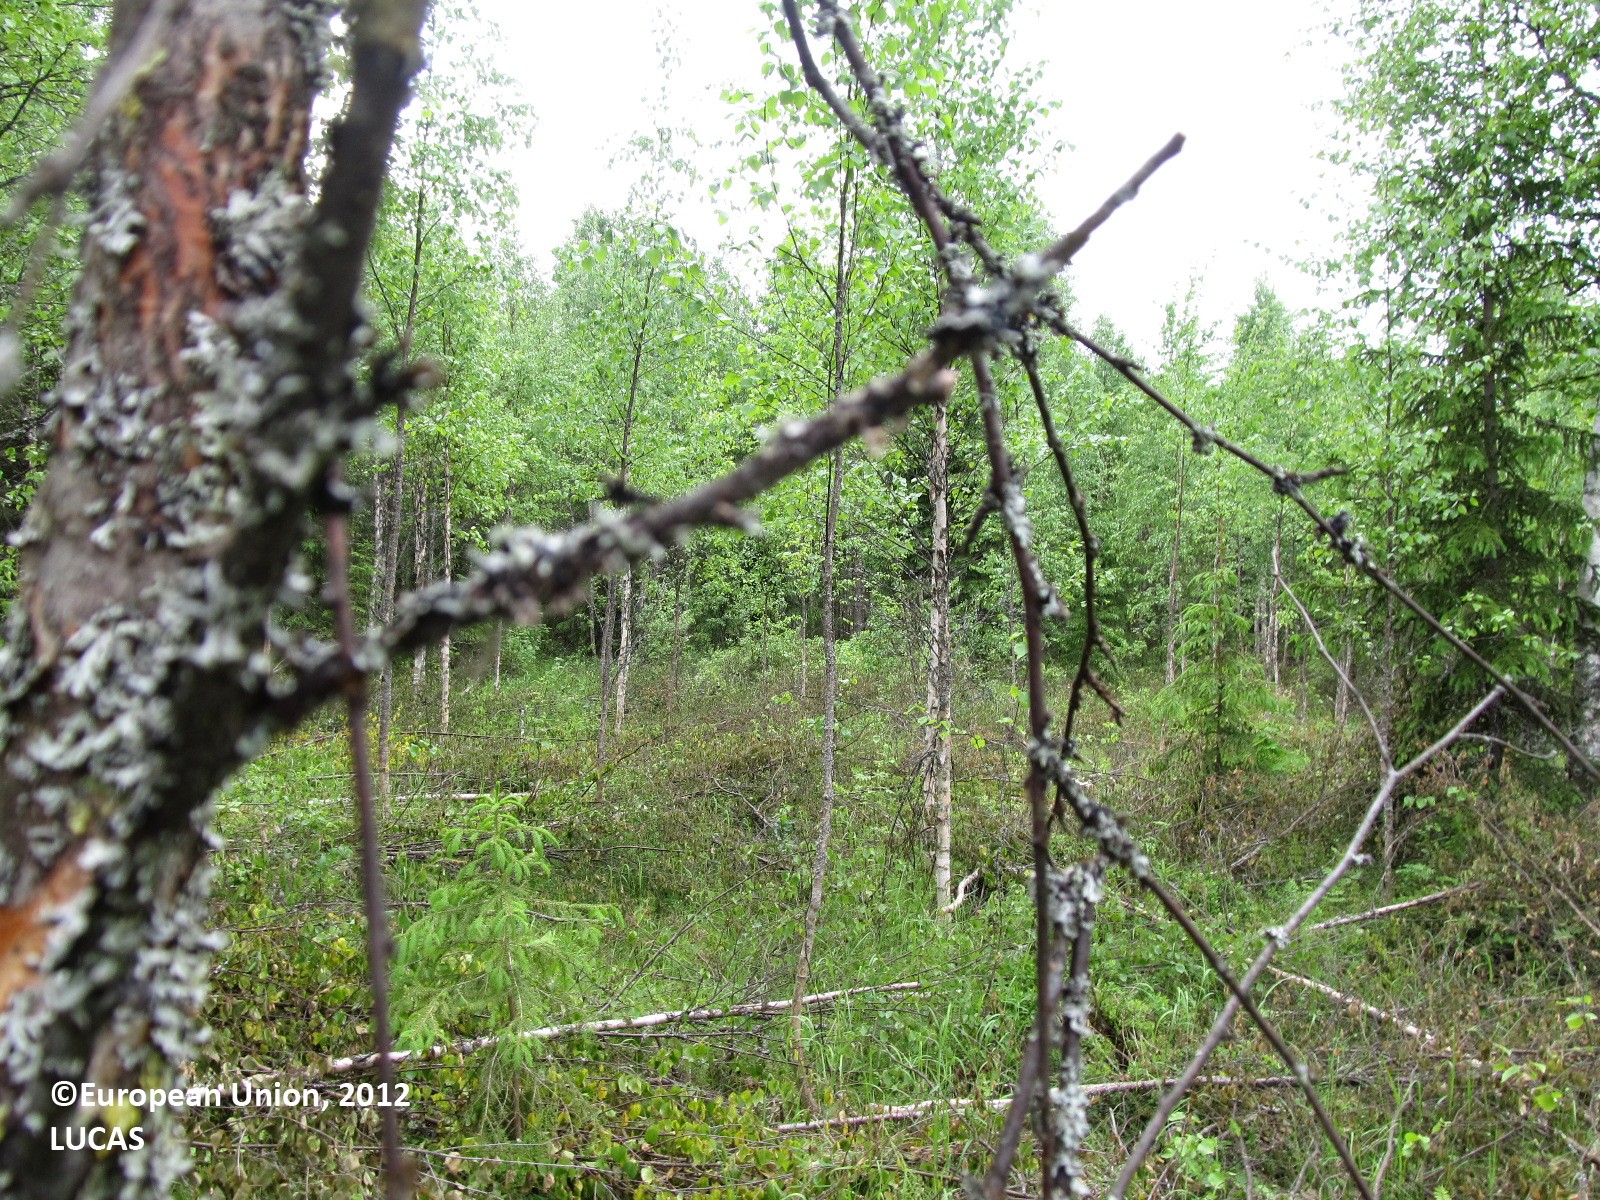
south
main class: Woodland
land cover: Spruce dominated mixed woodland
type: boreal forest
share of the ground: 10 - 25 %
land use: Forestry
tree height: < 5 m
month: June
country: FI
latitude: 63.1878
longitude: 27.8360
